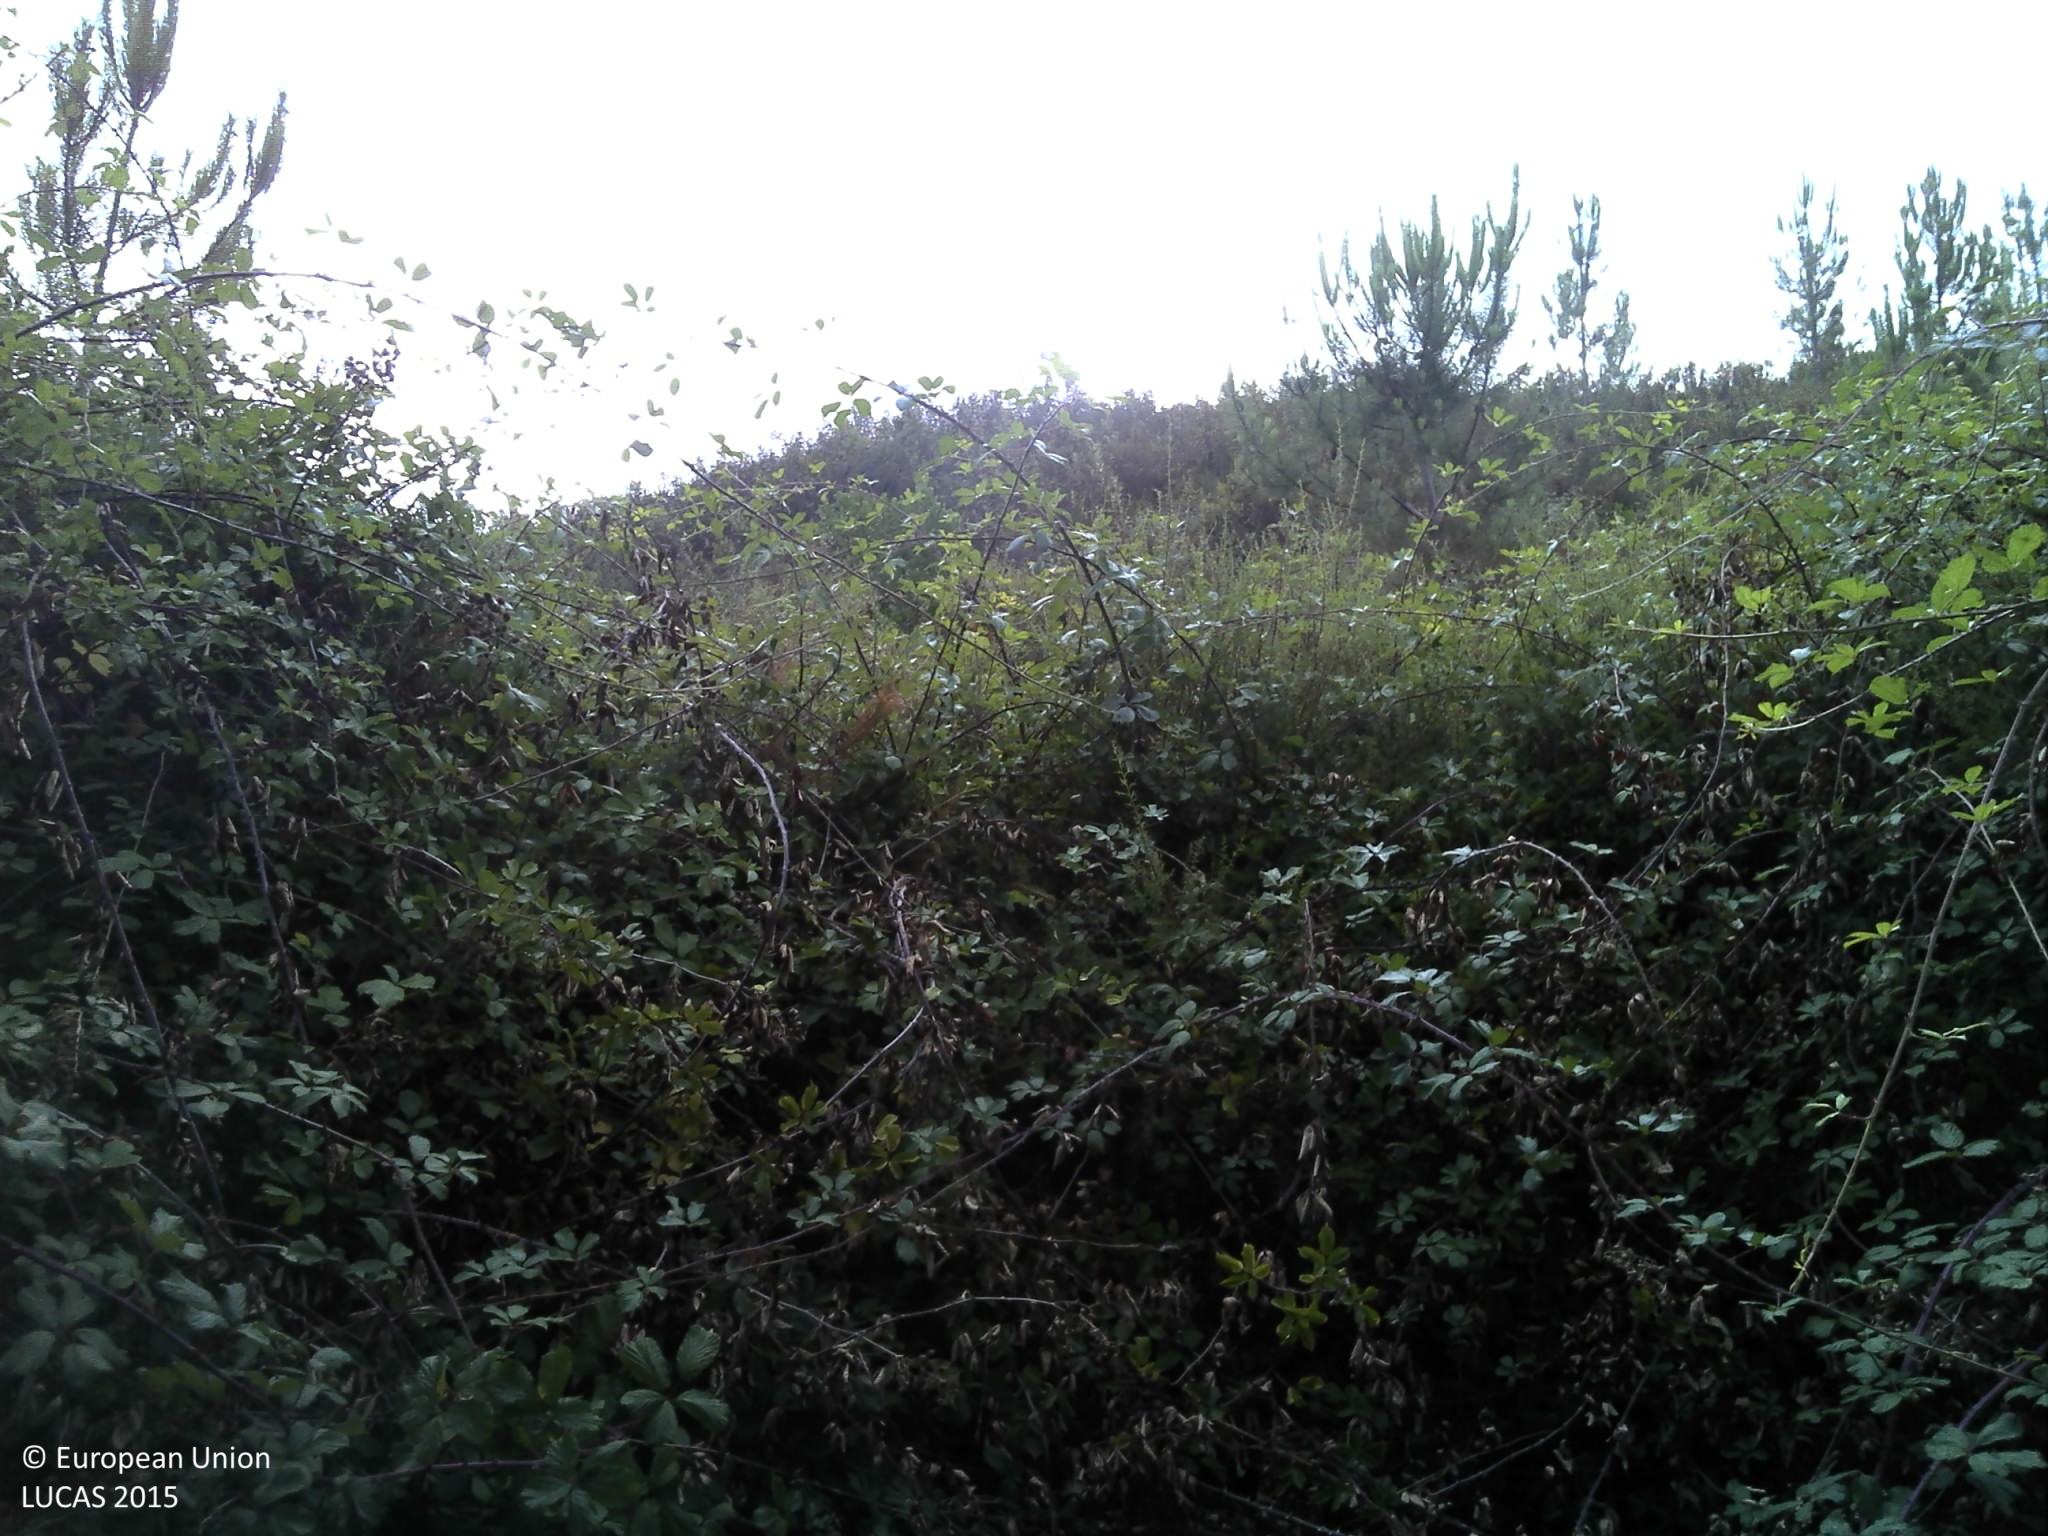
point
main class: Shrubland
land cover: Shrubland without tree cover
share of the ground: > 75 %
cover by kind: shrubs 80 %, unconsolidated bare surface 20 %
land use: Forestry
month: July
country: PT
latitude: 37.3850
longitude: -8.7508
